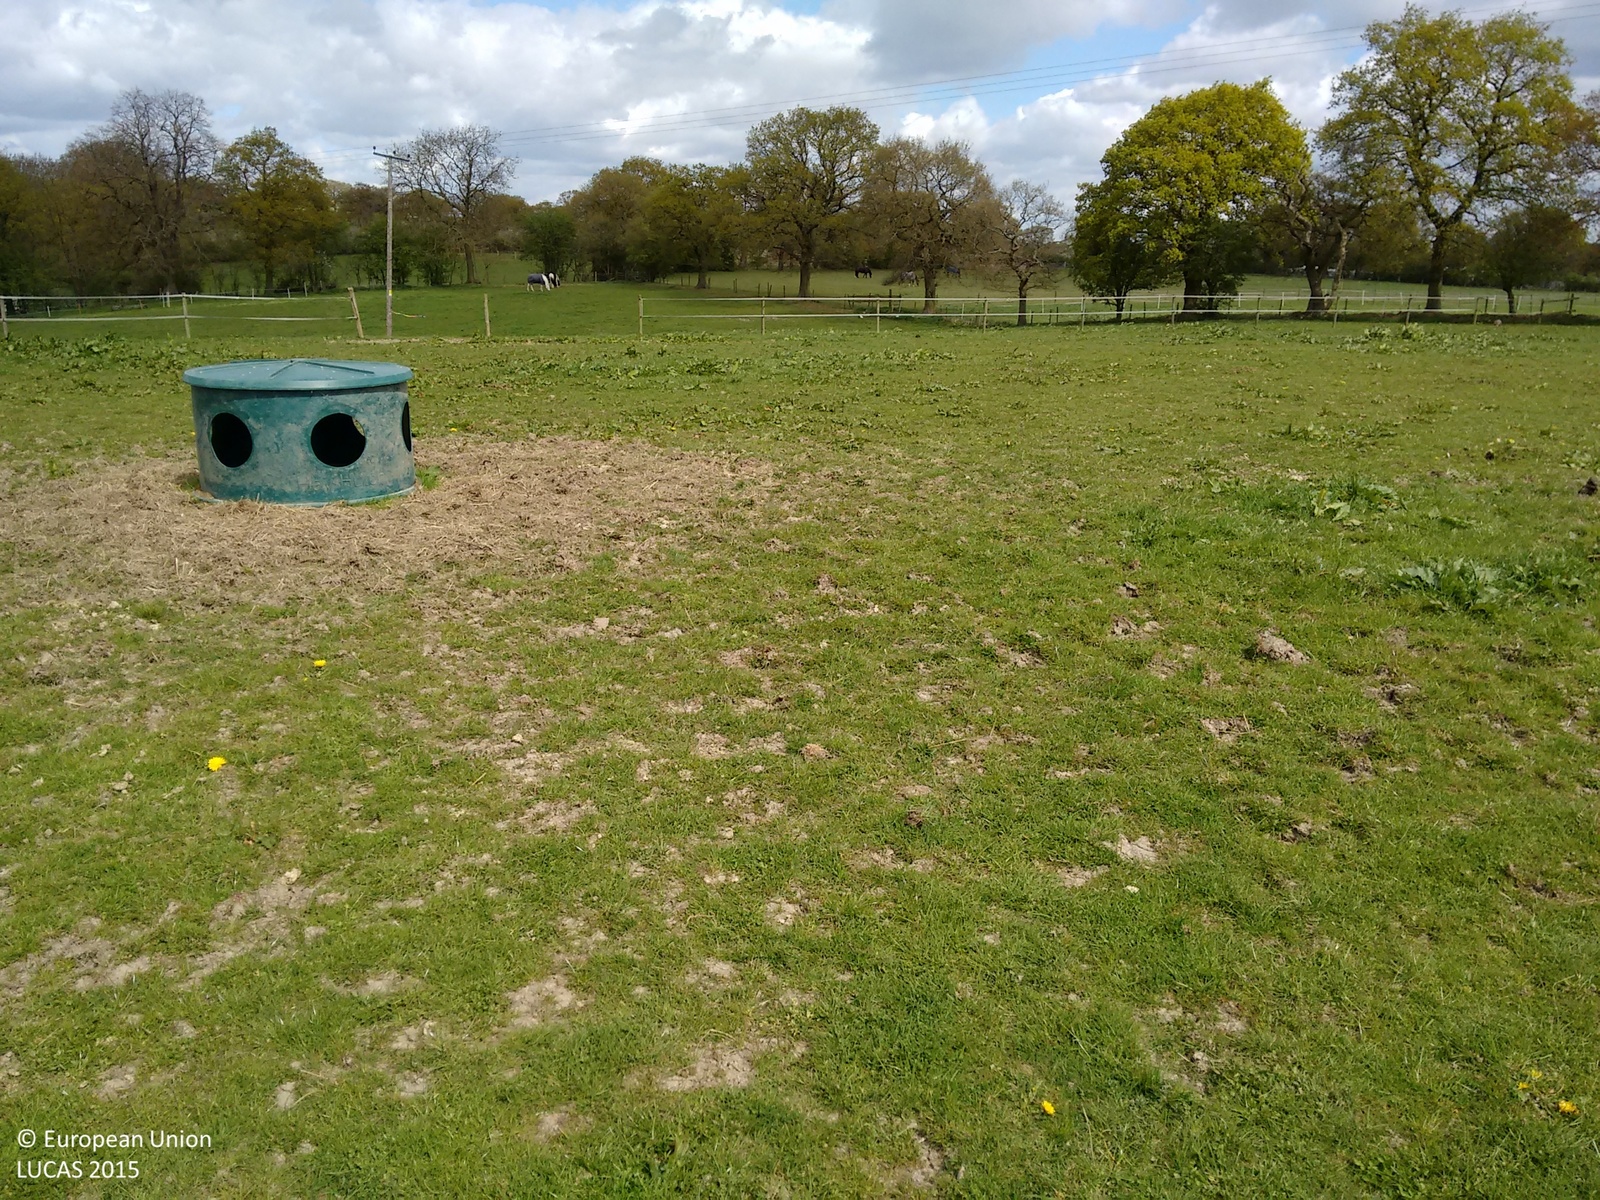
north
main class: Grassland
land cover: Grassland without tree/shrub cover
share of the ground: > 75 %
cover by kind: herbaceous plants 100 %
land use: Agriculture (excluding fallow land and kitchen gardens)
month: April
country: GB
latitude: 52.3575
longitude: -1.9063
